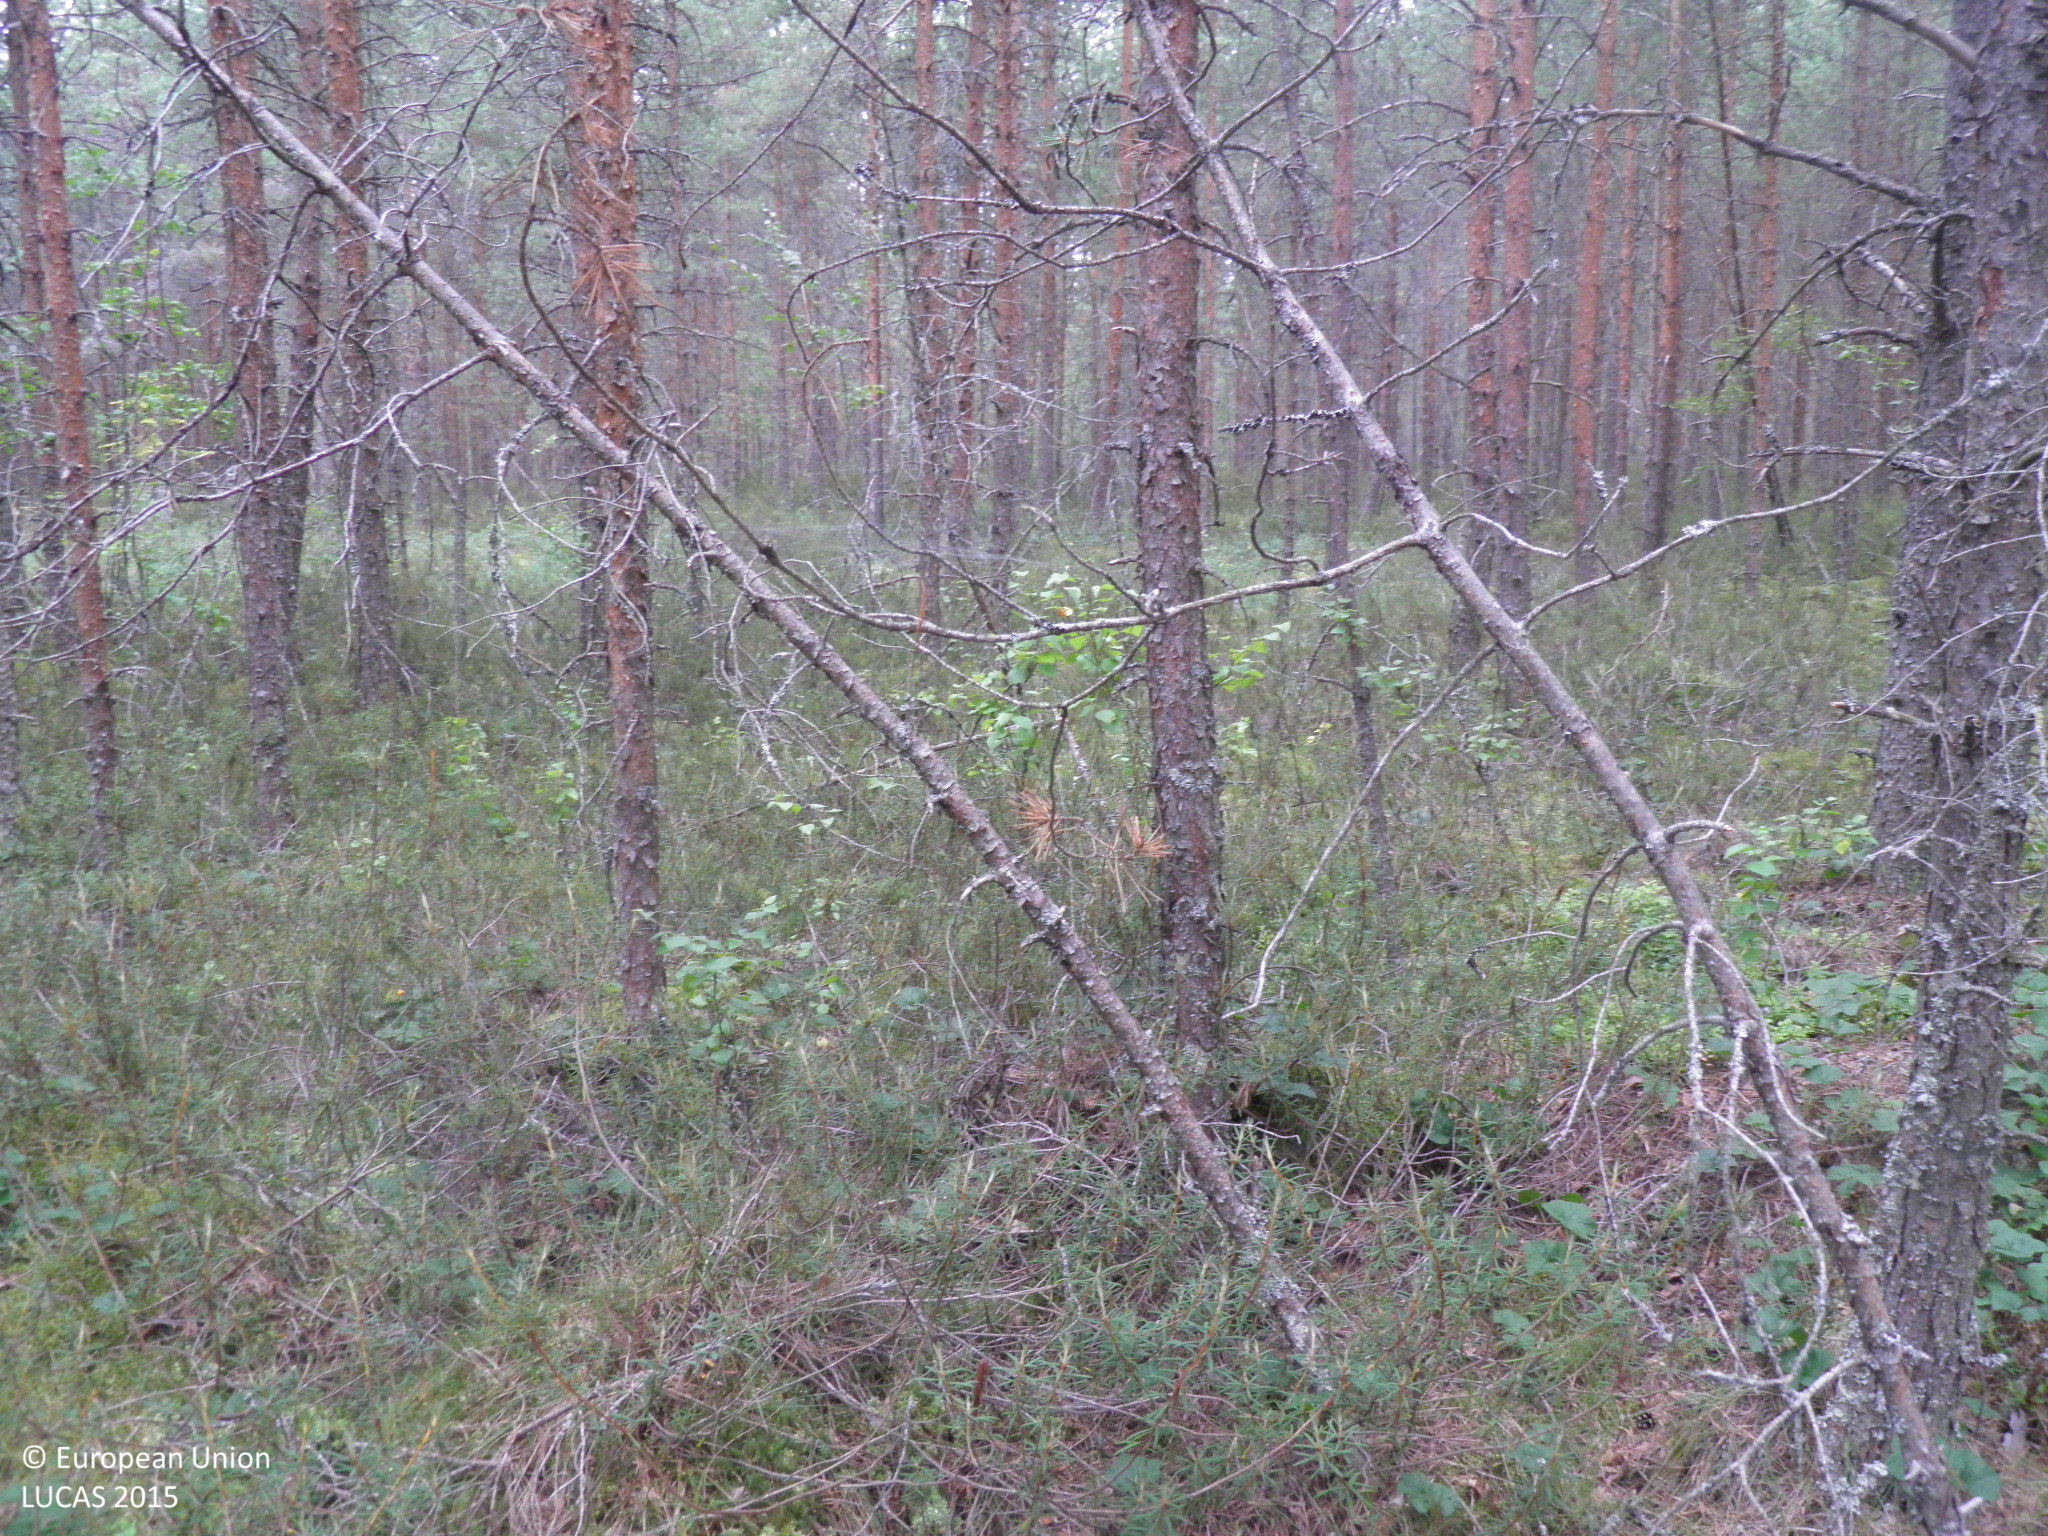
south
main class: Woodland
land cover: Pine dominated coniferous woodland
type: mire and swamp forests
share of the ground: 50 - 75 %
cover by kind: coniferous forest trees 50 %, shrubs 25 %, lichens and mosses 25 %
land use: Forestry
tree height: > 5 m
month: August
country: FI
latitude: 61.0617
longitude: 22.9495
